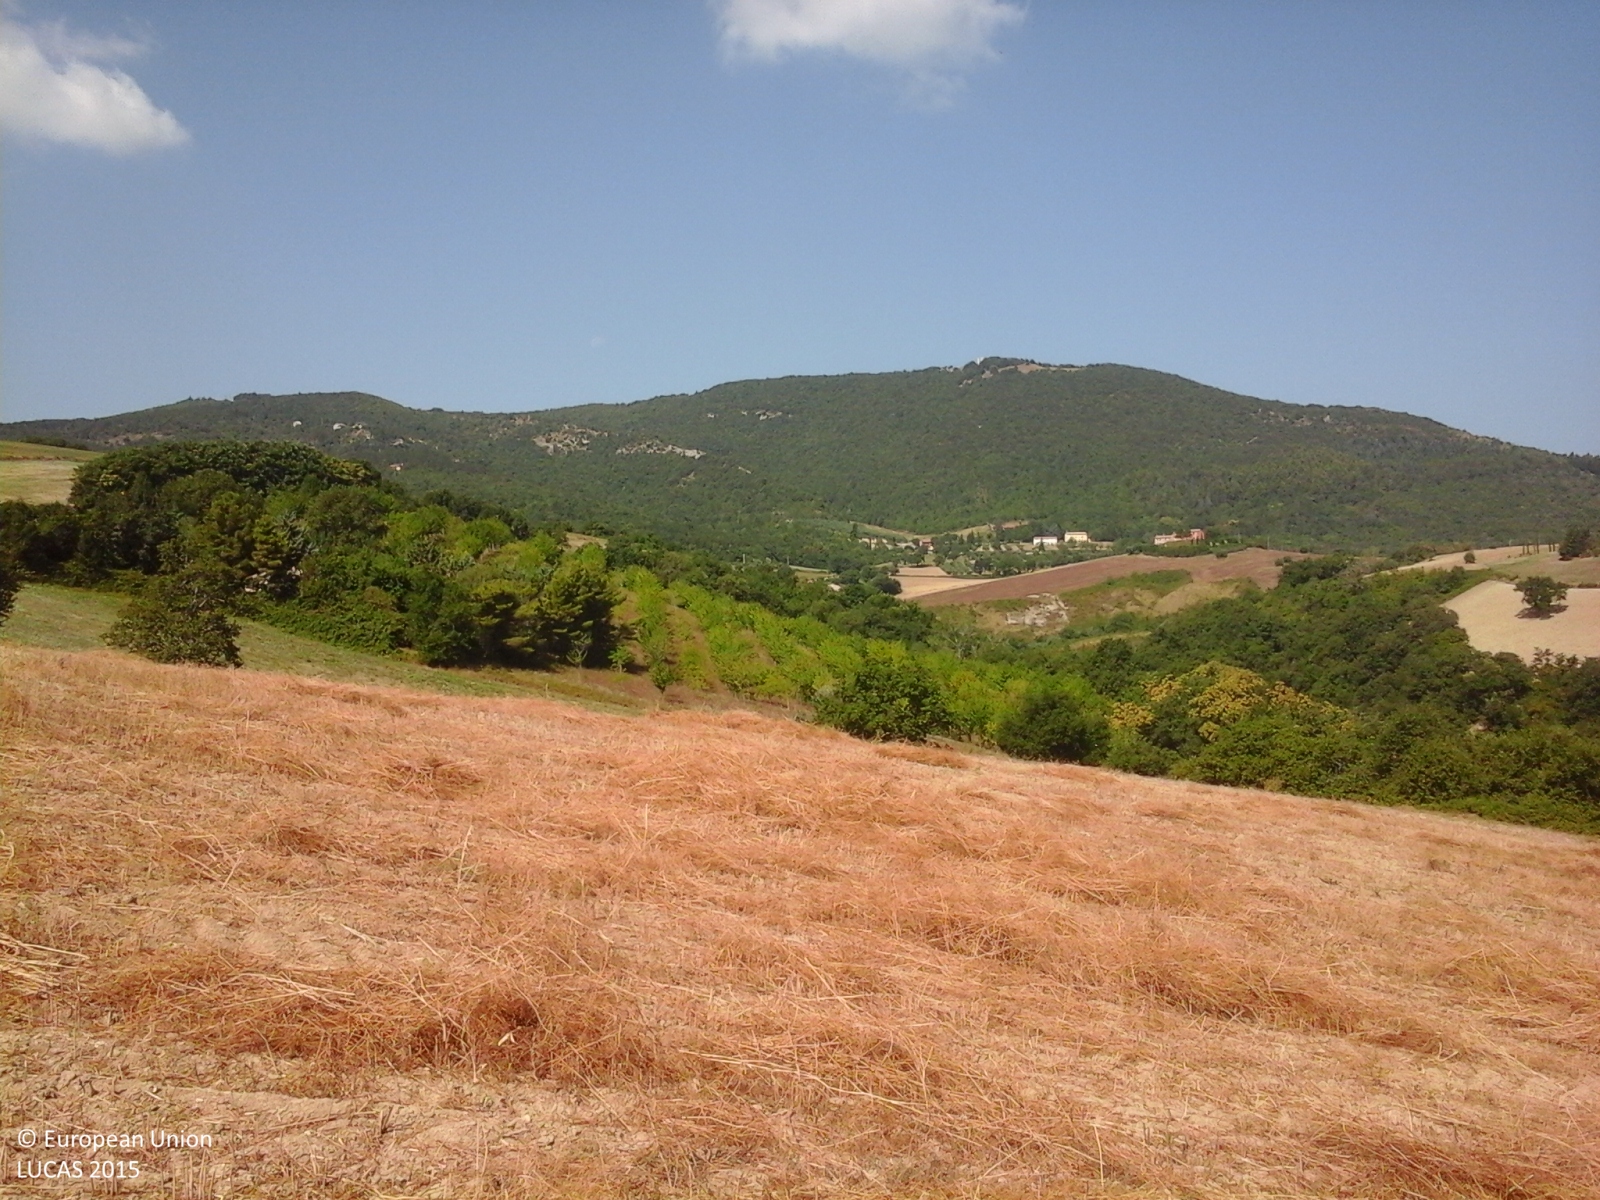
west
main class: Cropland
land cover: Other non-permanent industrial crops
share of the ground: > 75 %
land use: Agriculture (excluding fallow land and kitchen gardens)
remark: Harvested field
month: August
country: IT
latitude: 43.3243
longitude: 13.2595
